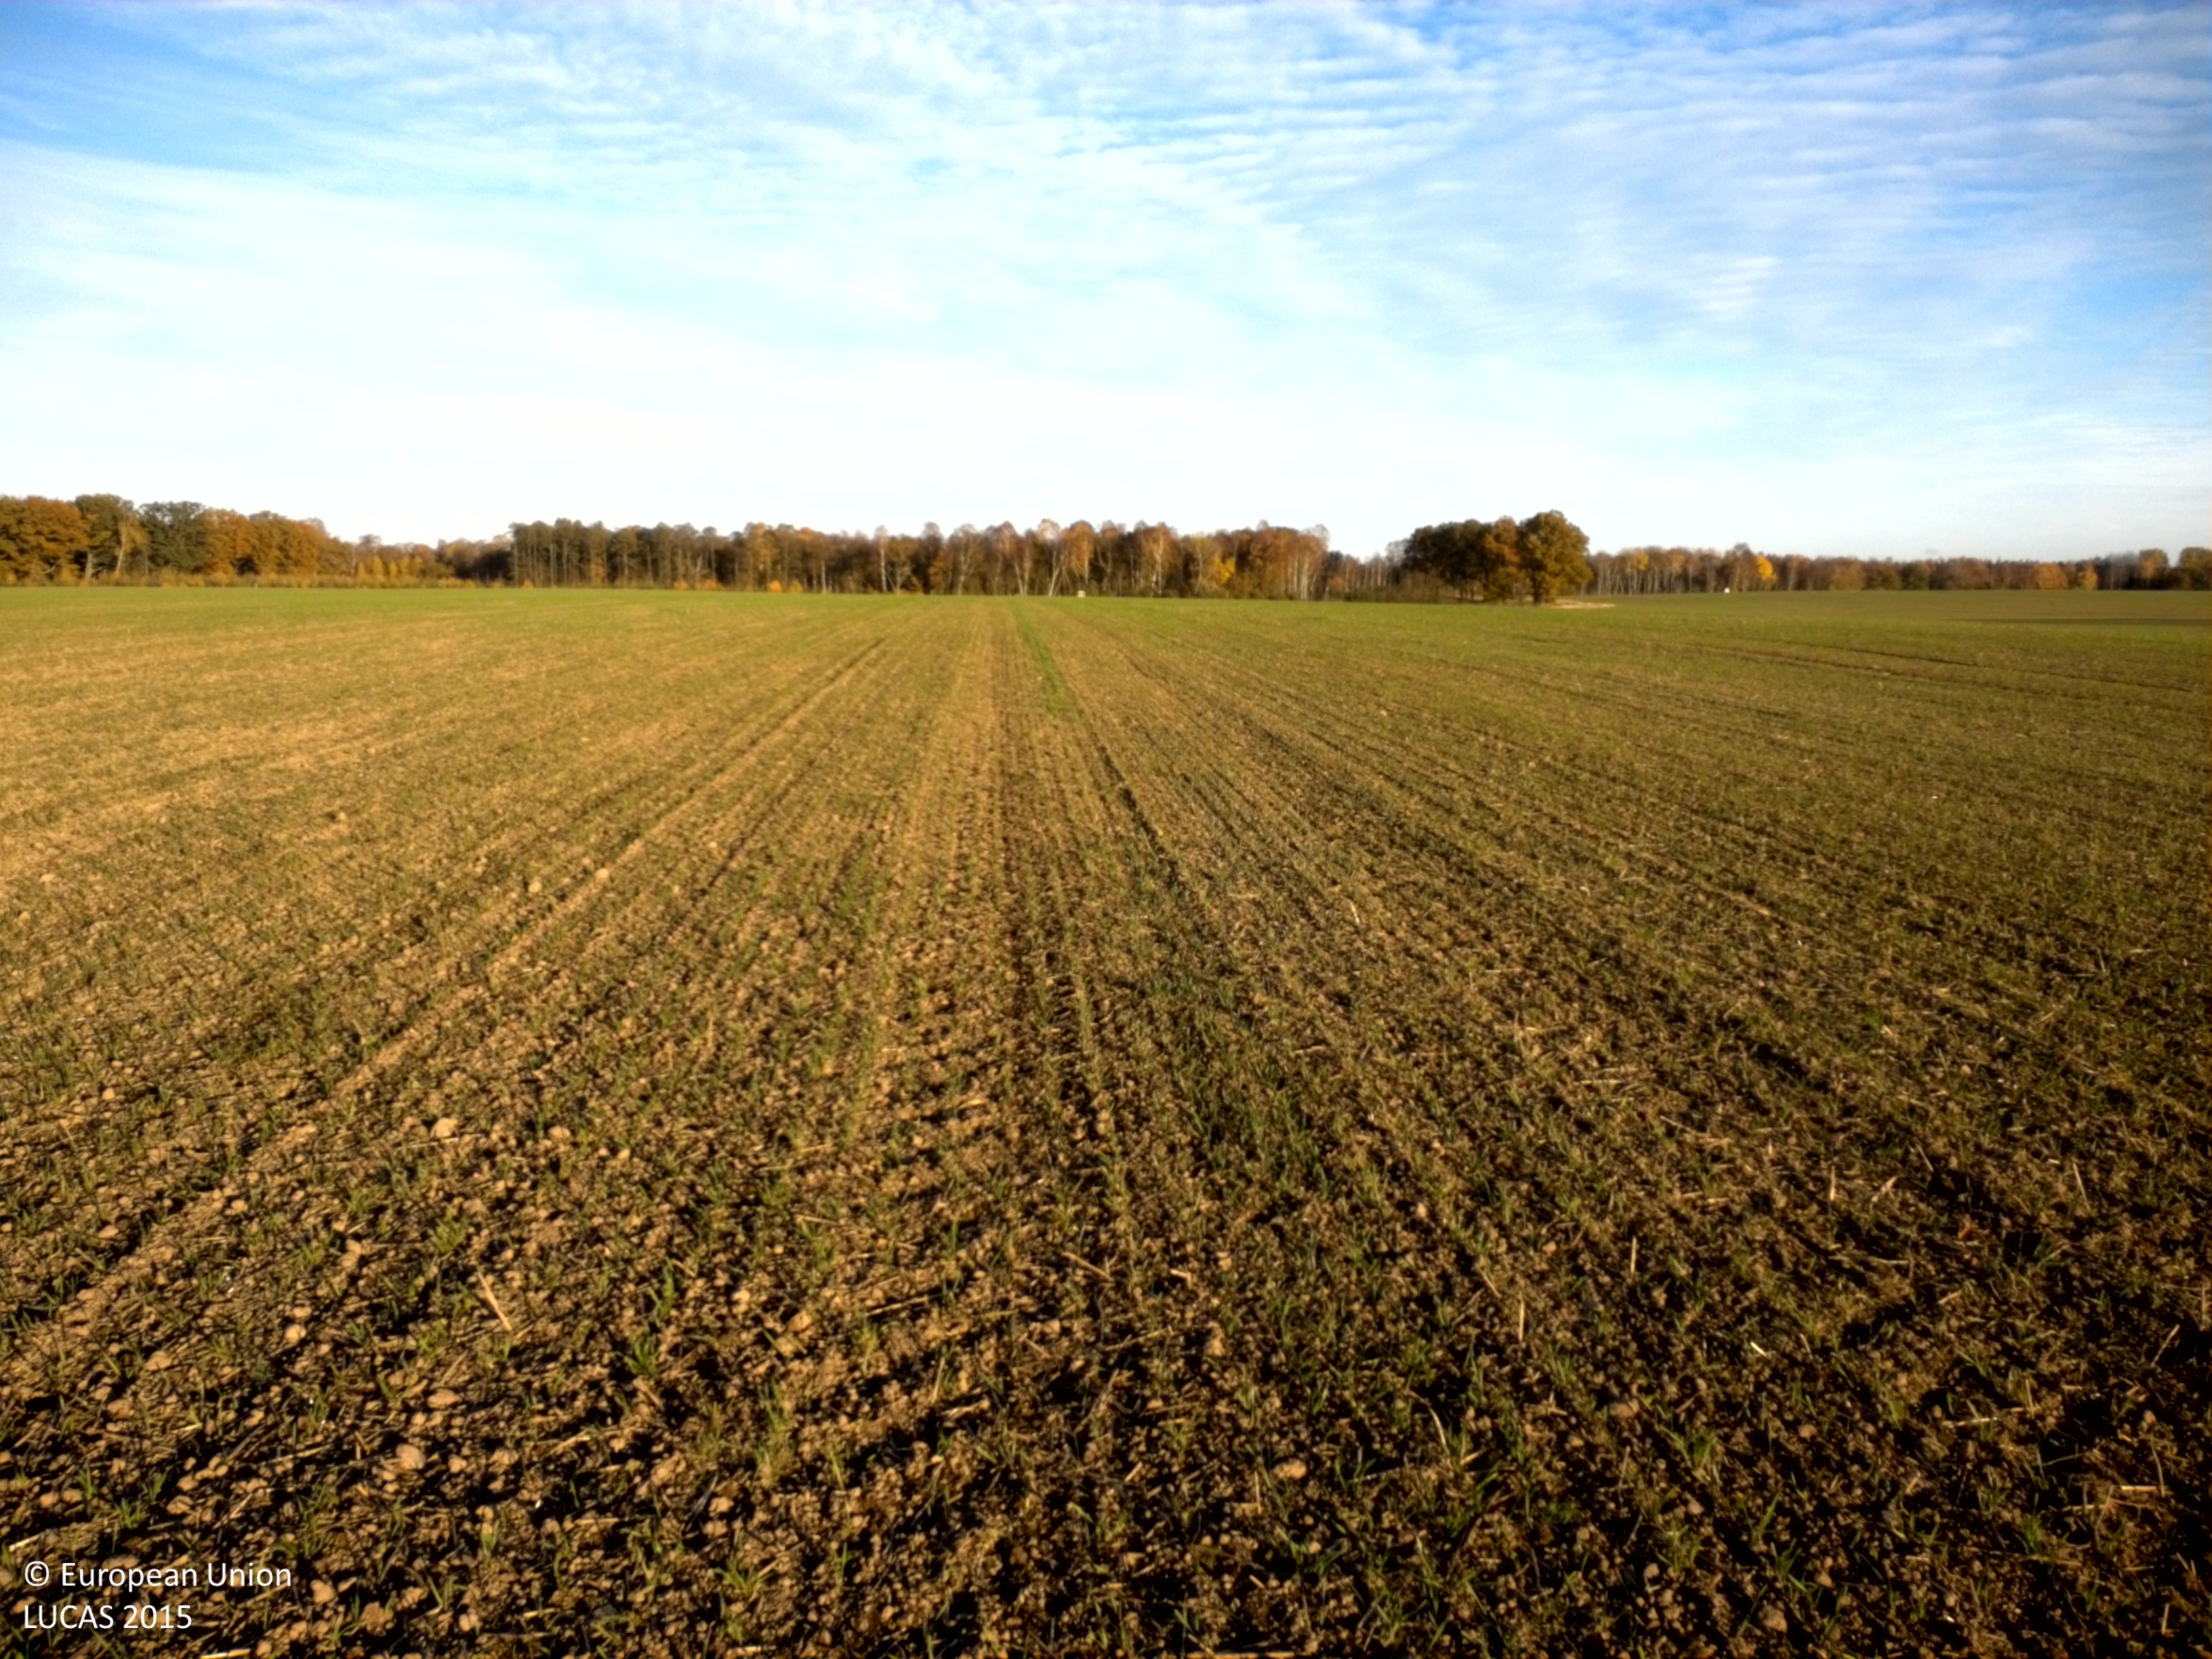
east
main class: Cropland
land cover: Common wheat
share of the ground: < 10 %
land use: Agriculture (excluding fallow land and kitchen gardens)
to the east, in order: Common wheat
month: October
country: SE
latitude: 55.9535
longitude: 13.0566
